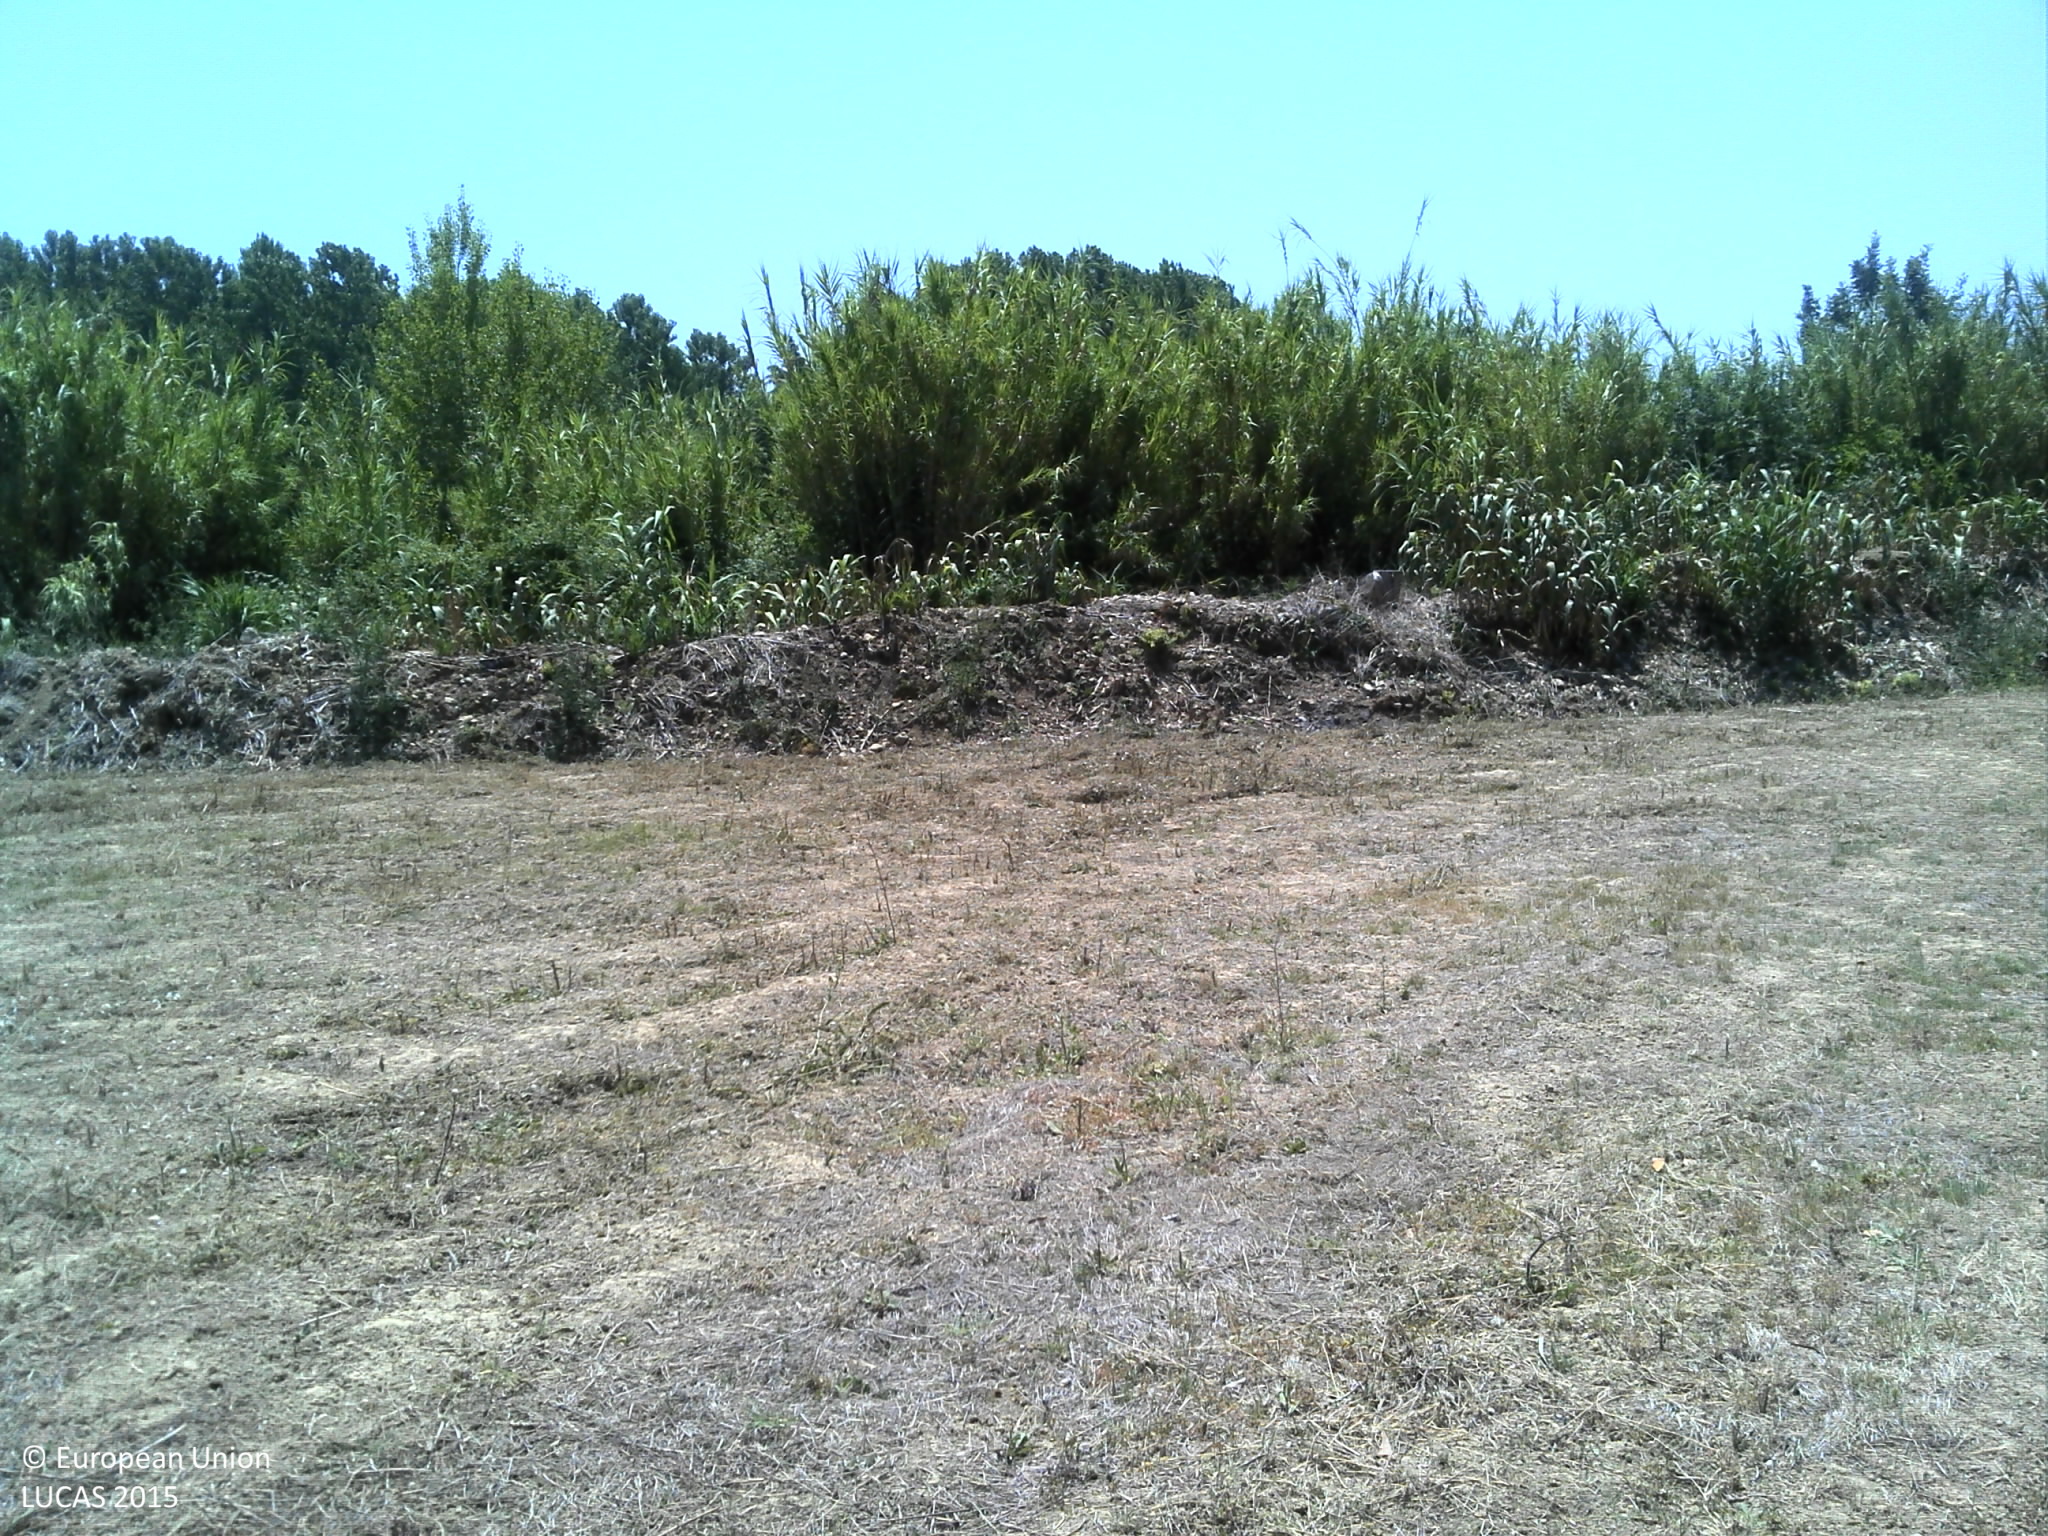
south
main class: Grassland
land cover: Grassland without tree/shrub cover
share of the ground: 50 - 75 %
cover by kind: herbaceous plants 55 %, unconsolidated bare surface 45 %
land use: Agriculture (excluding fallow land and kitchen gardens)
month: July
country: PT
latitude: 40.0978
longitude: -8.5118
